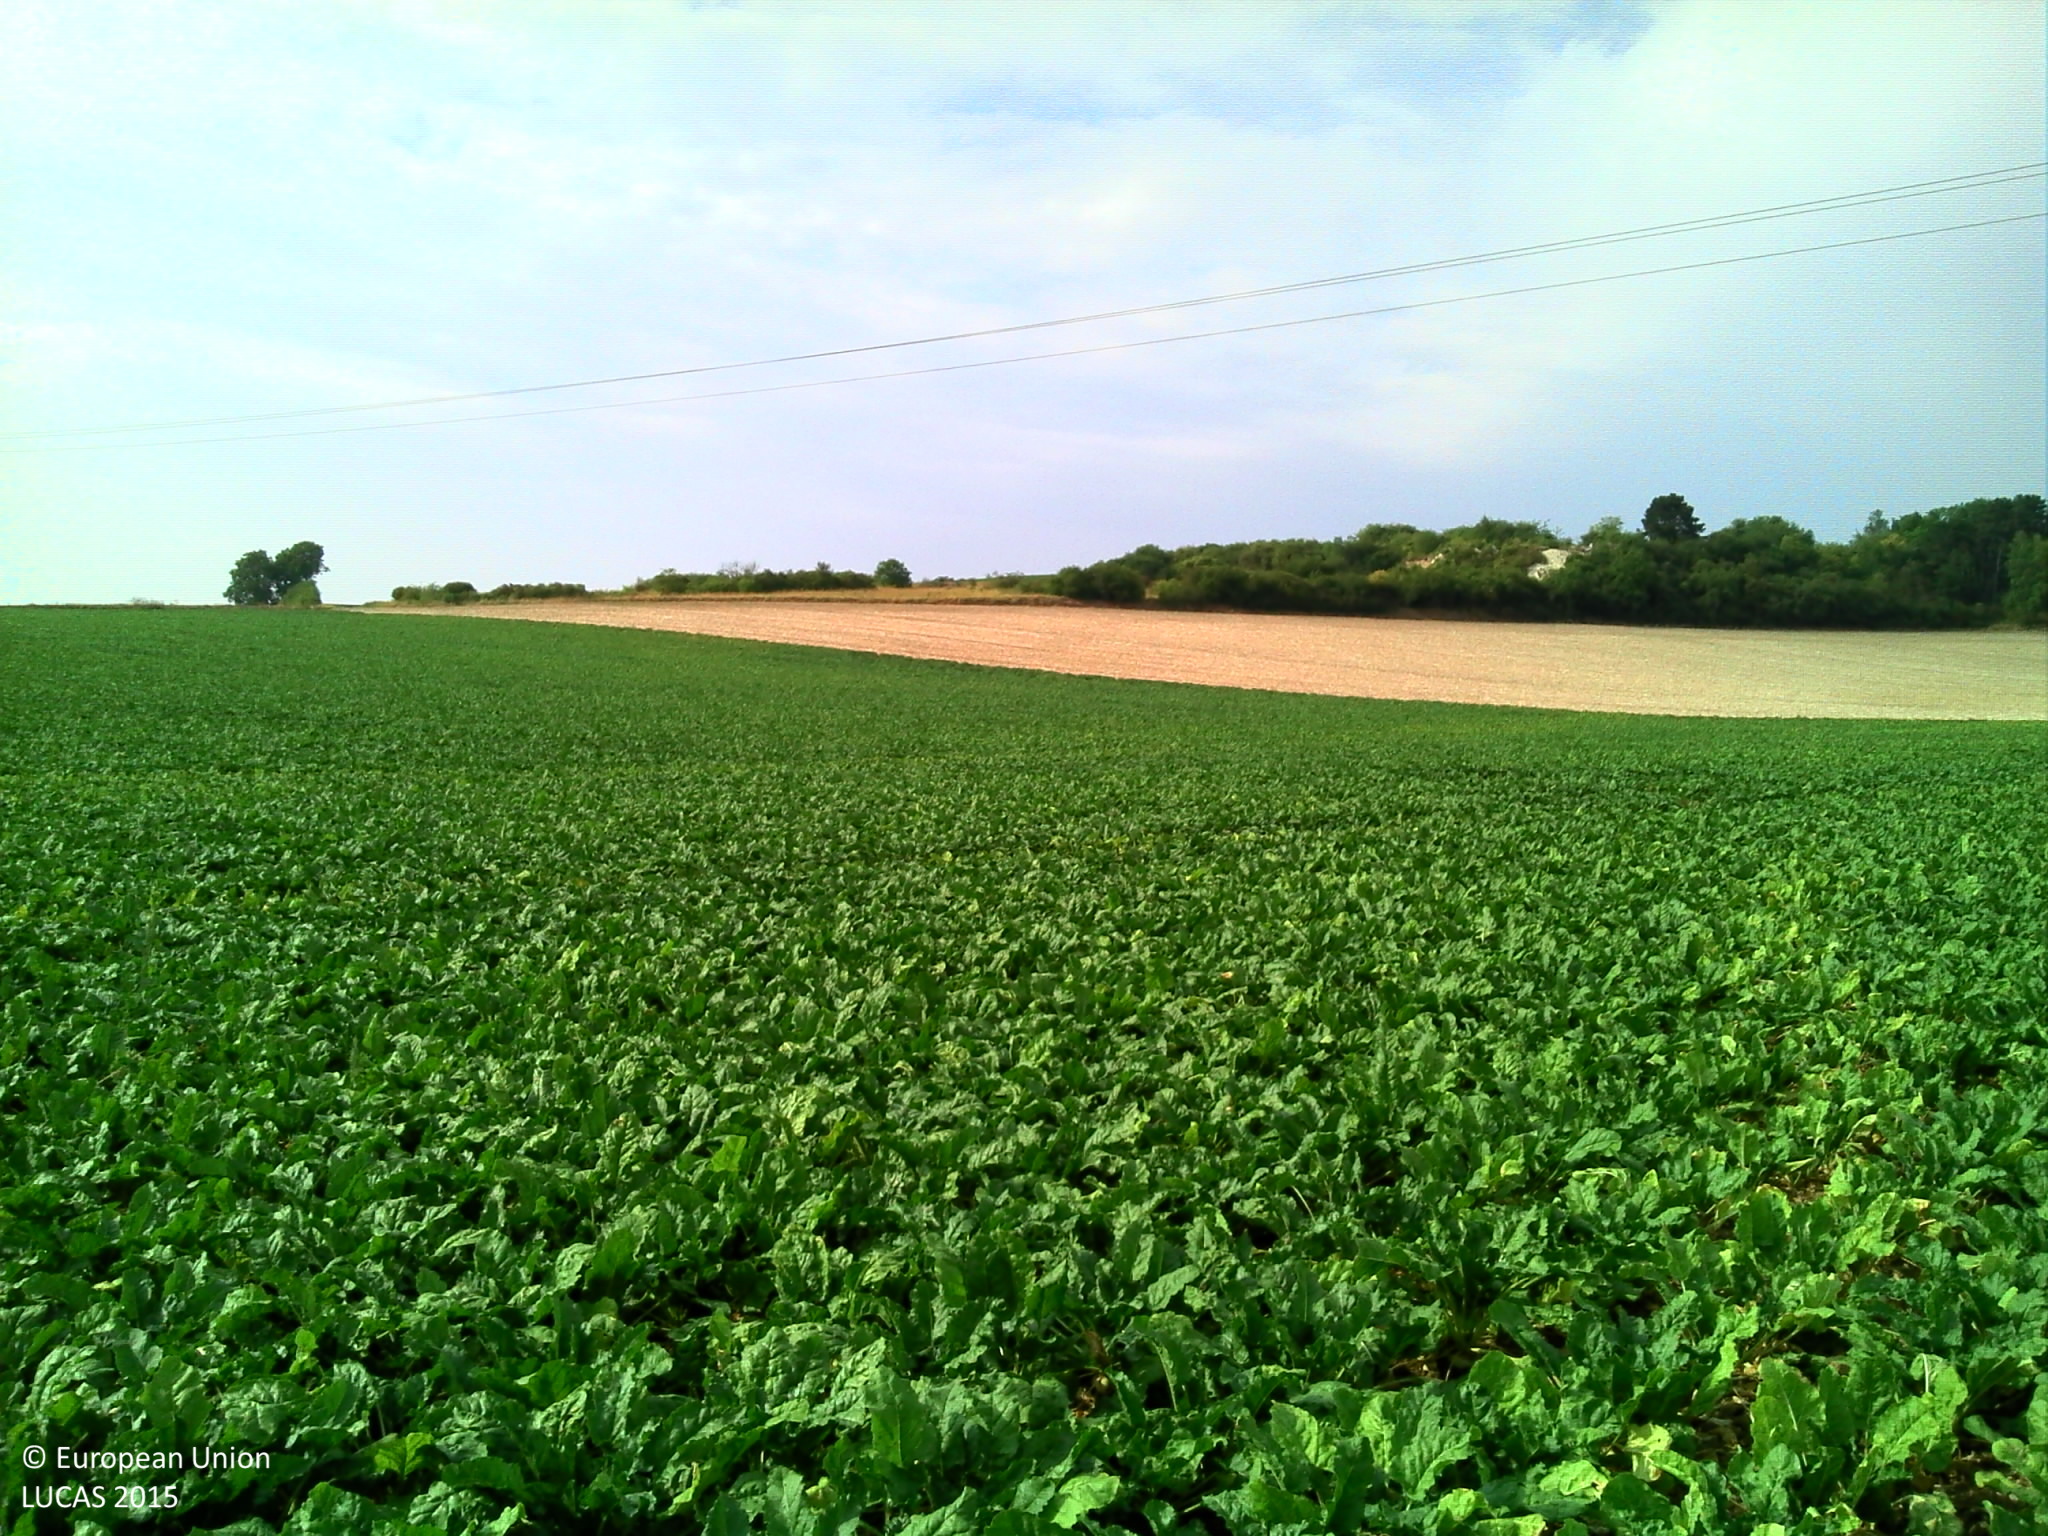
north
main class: Cropland
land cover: Sugar beet
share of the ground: > 75 %
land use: Agriculture (excluding fallow land and kitchen gardens)
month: August
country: FR
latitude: 49.2711
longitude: 3.7129
